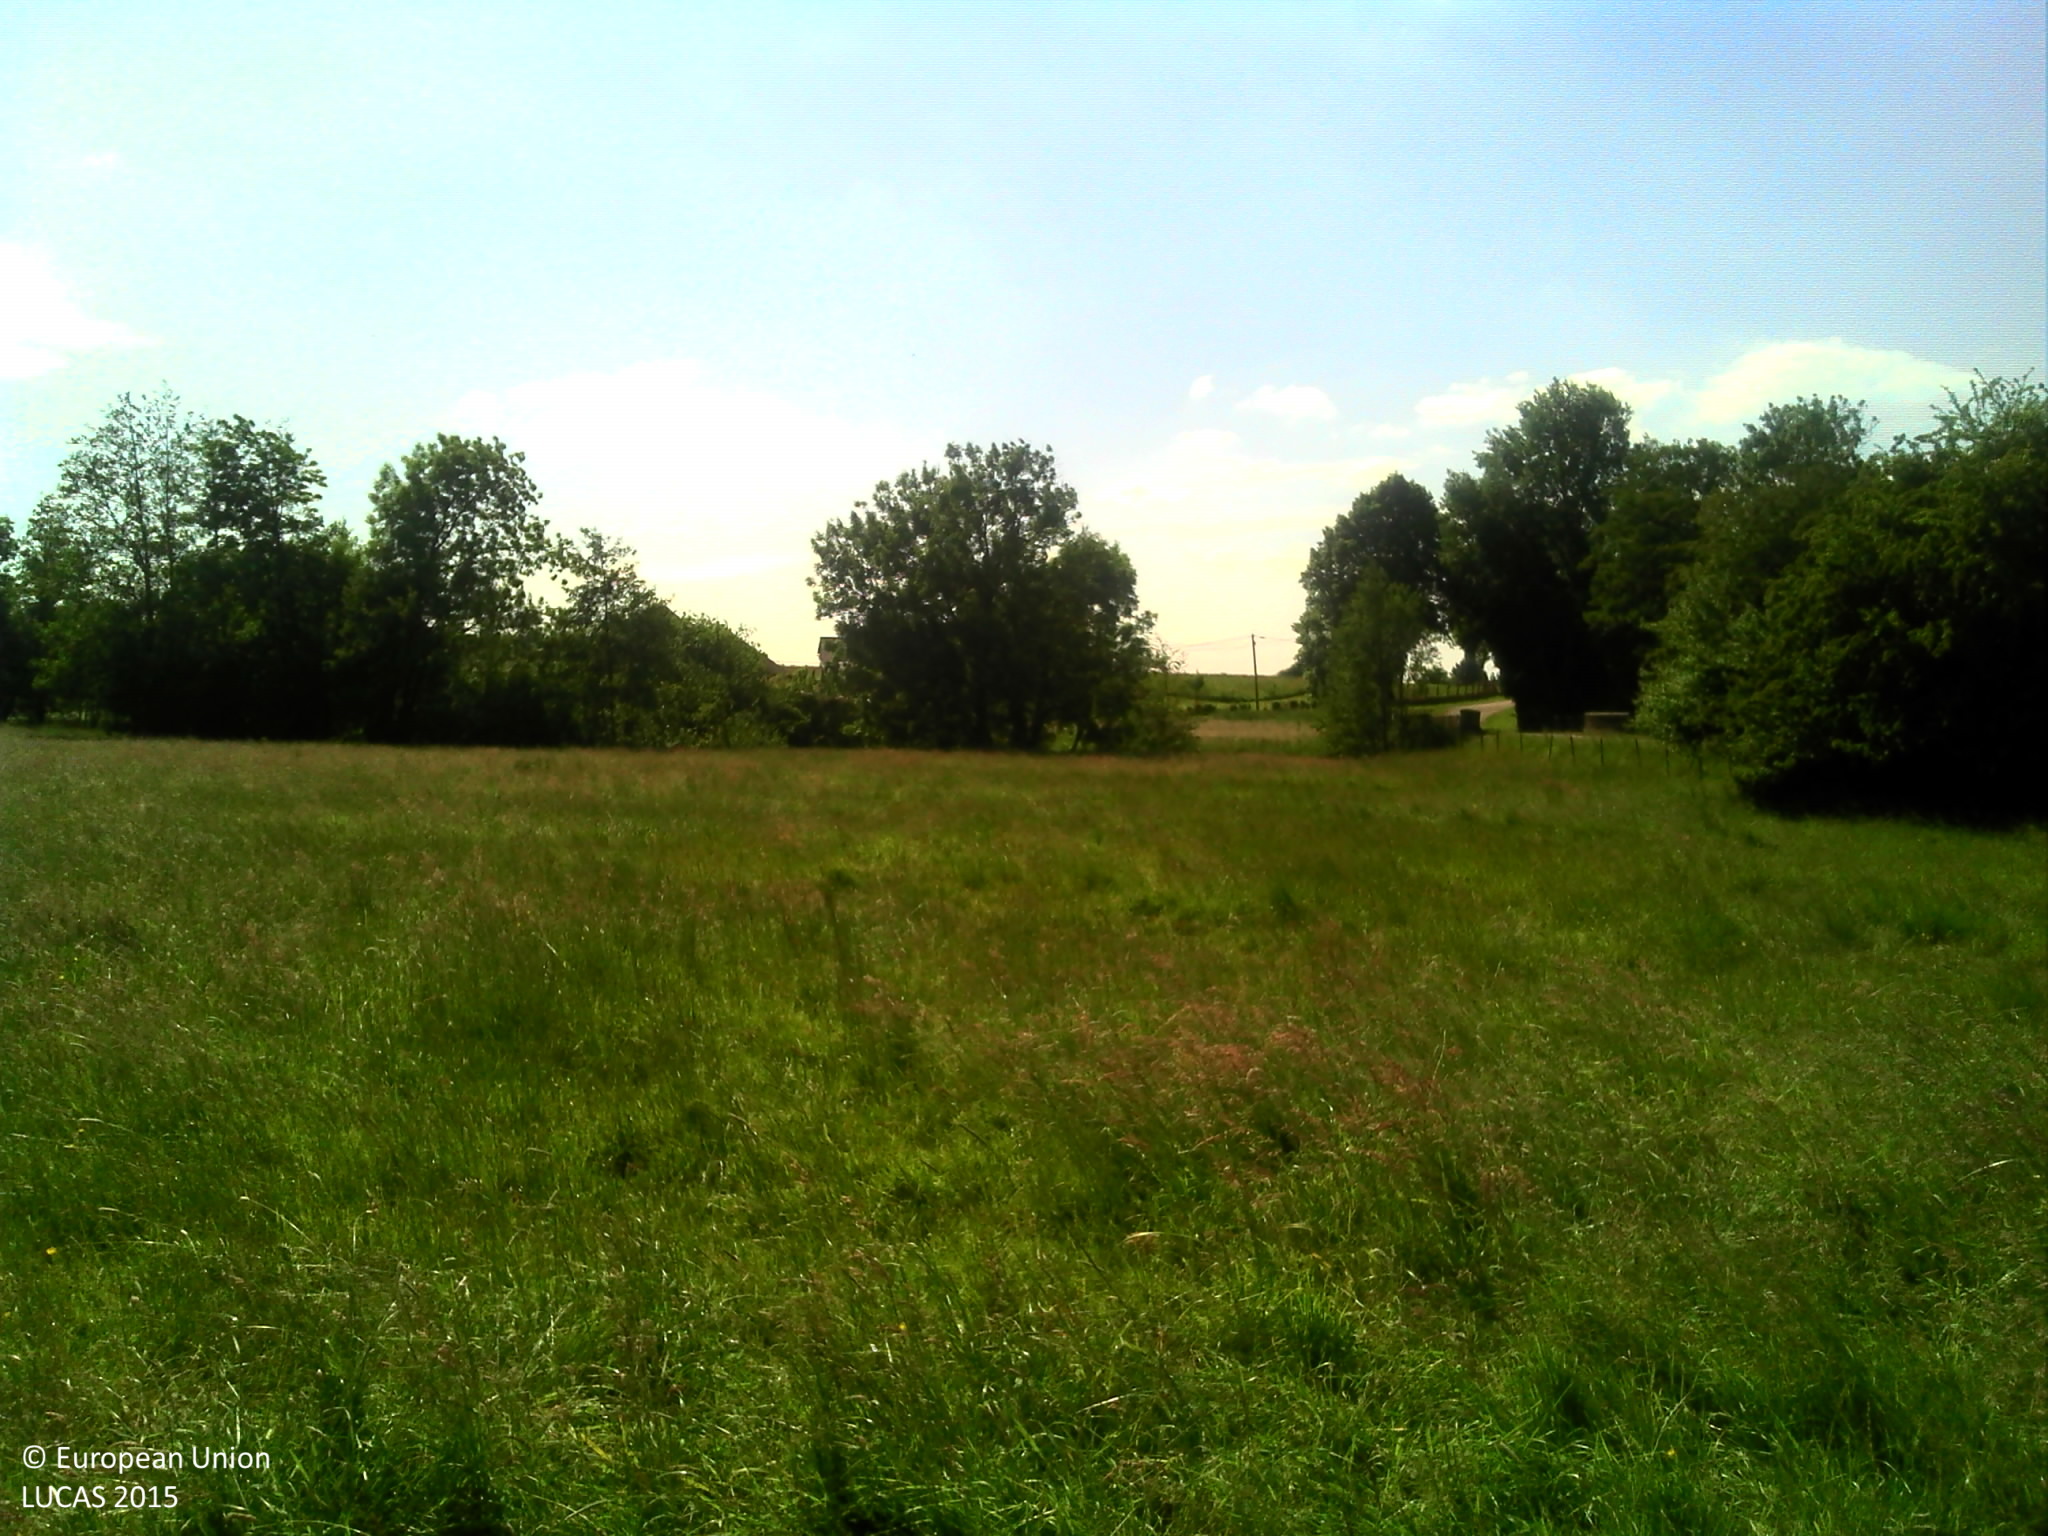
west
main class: Grassland
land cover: Grassland without tree/shrub cover
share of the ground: > 75 %
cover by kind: herbaceous plants 100 %
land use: Agriculture (excluding fallow land and kitchen gardens)
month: June
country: FR
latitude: 49.8697
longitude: 4.1095
